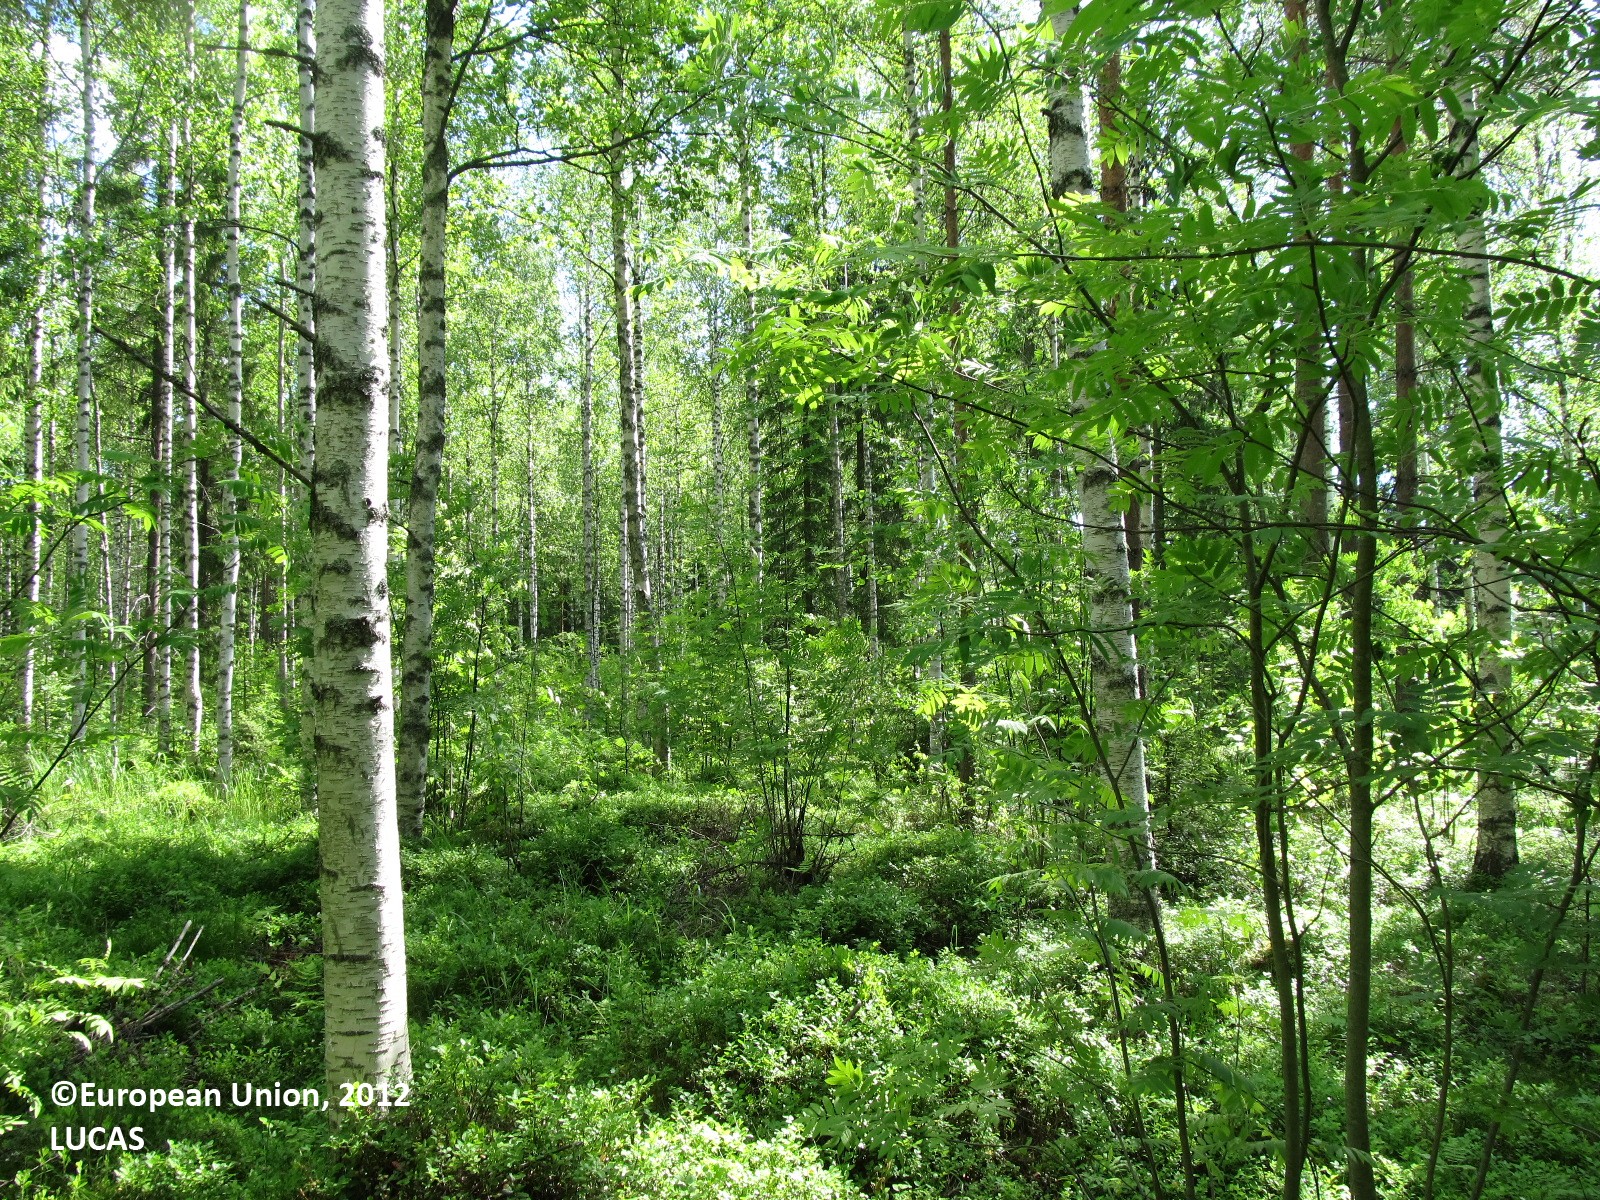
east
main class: Woodland
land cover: Broadleaved woodland
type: boreal forest
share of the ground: 25 - 50 %
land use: Forestry
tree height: > 5 m
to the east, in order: Broadleaved woodland; Spruce dominated mixed woodland; Artificial constructions in urban areas; Spruce dominated mixed woodland; Broadleaved woodland; Ditches and canals; Grass margins; Paved roads, cycling and walking lanes; Grass margins; Ditches and canals; Spruce dominated coniferous woodland; Electric lines; Grassland without tree/shrub cover; Ditches and canals; Grass margins; Paved roads, cycling and walking lanes; Grass margins; Electric lines; Ditches and canals; Grass margins; Electric lines; Paved roads, cycling and walking lanes
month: June
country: FI
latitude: 62.8061
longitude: 27.6038
